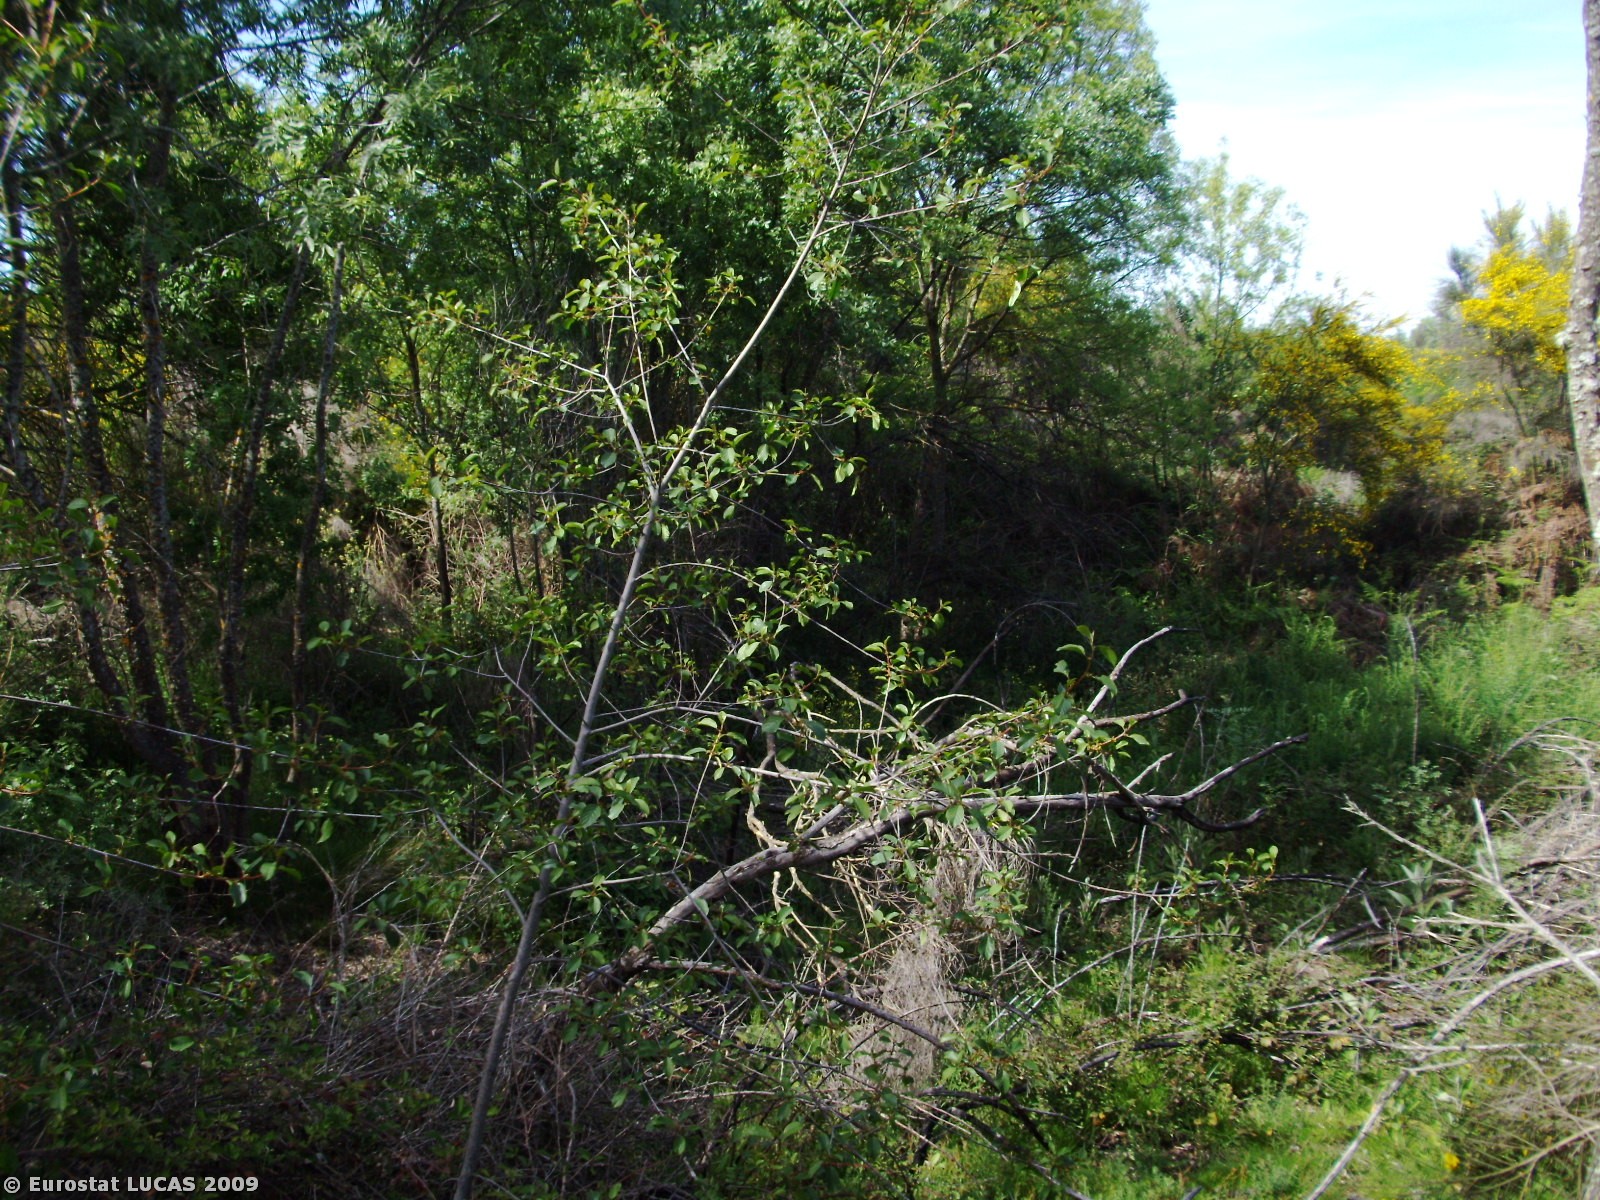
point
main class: Woodland
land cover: Broadleaved woodland
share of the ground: > 75 %
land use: Forestry
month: May
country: PT
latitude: 40.9756
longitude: -7.3591
